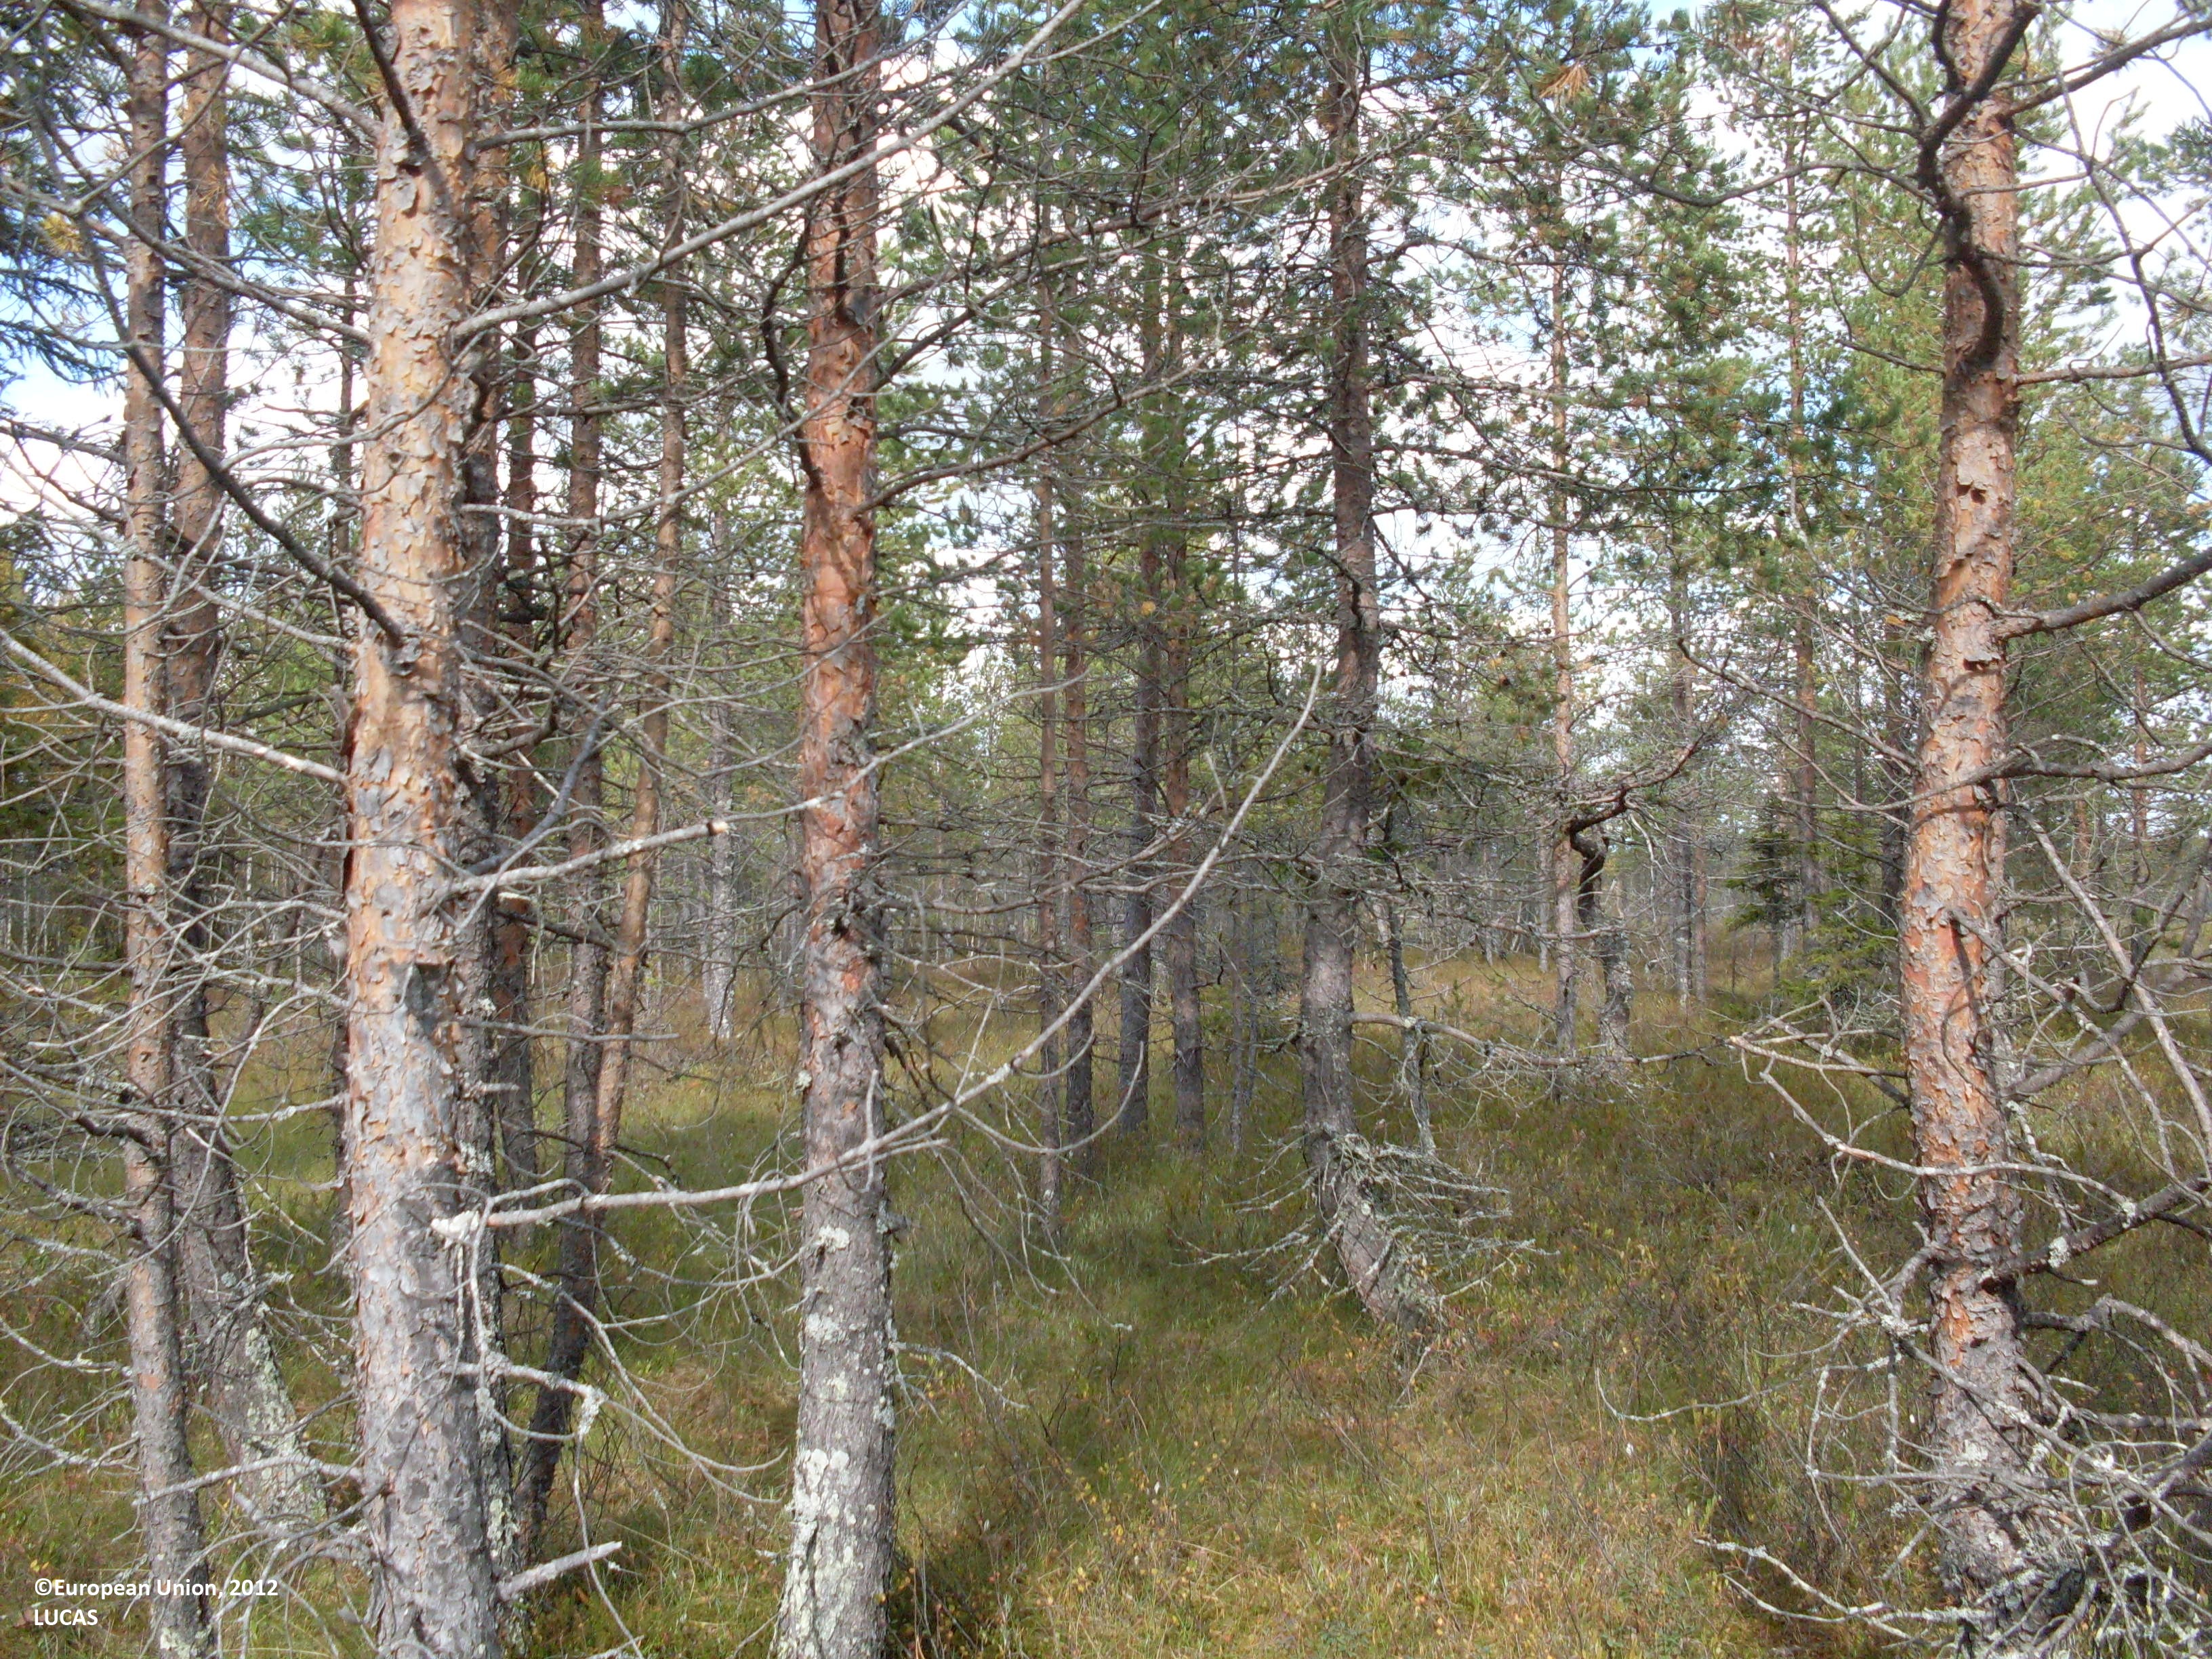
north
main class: Woodland
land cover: Pine dominated coniferous woodland
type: boreal forest
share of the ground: 25 - 50 %
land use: Forestry
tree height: > 5 m
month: September
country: FI
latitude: 64.1900
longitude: 30.1512
